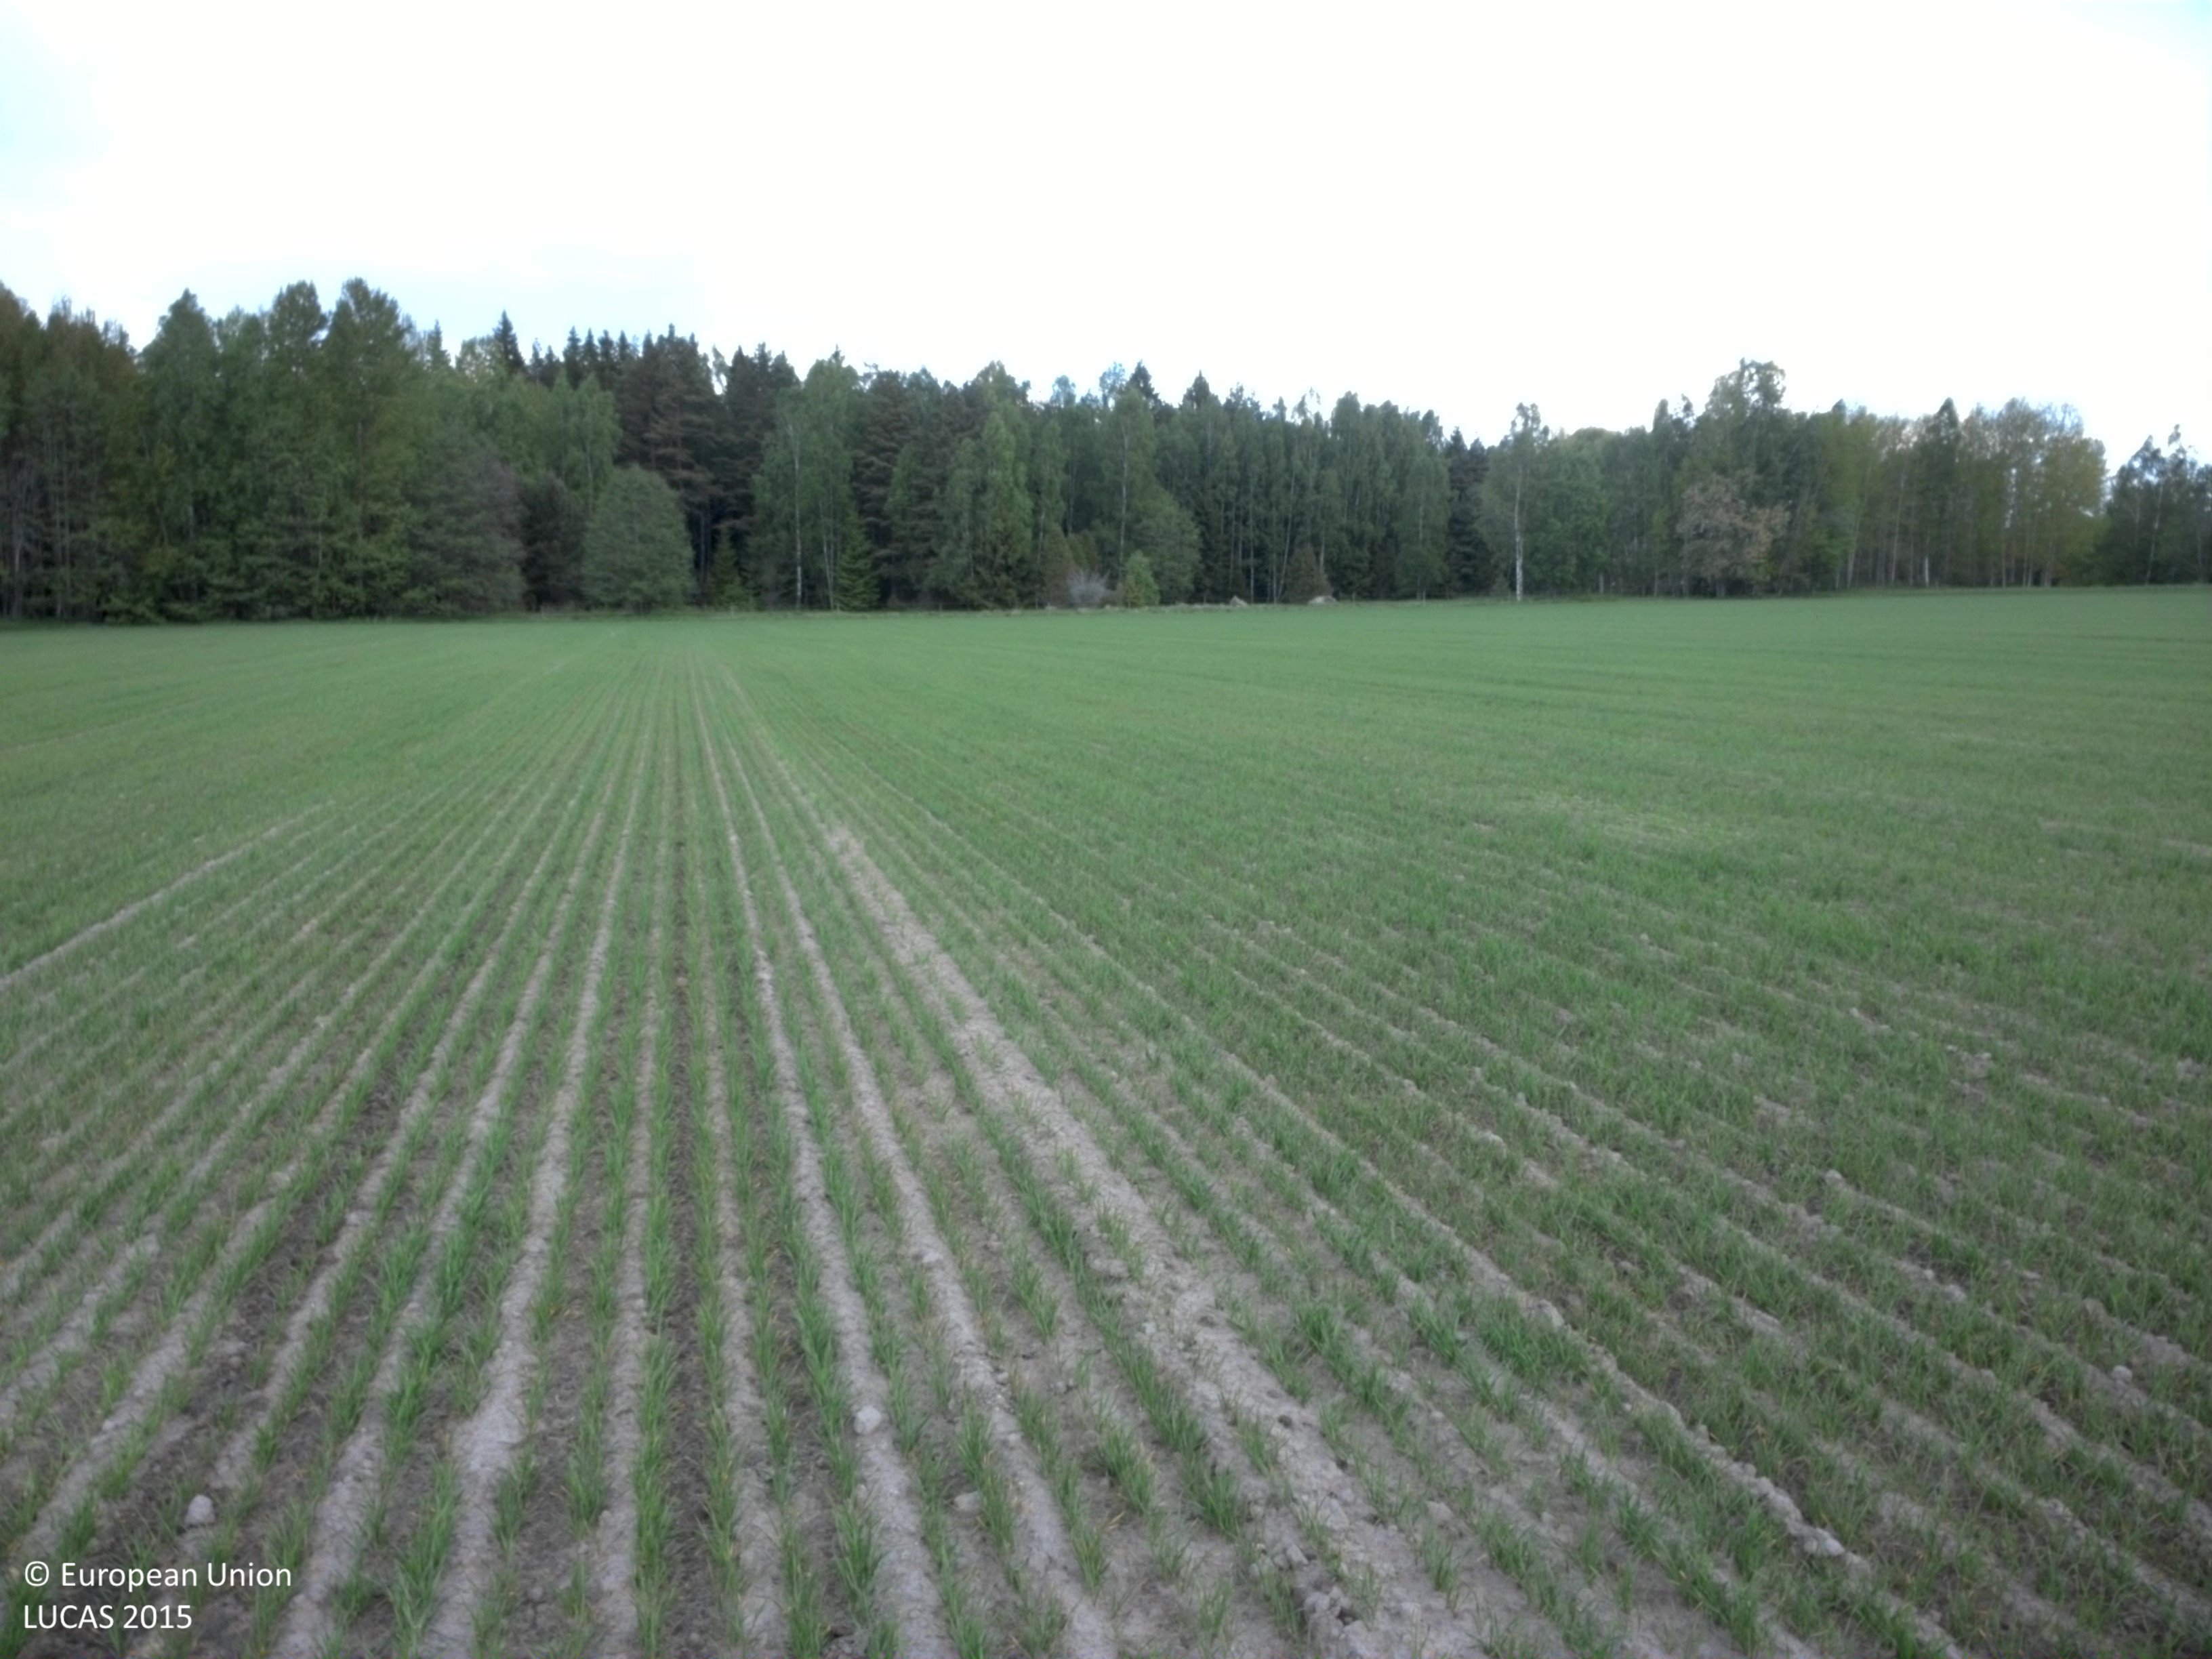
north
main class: Cropland
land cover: Common wheat
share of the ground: 50 - 75 %
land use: Agriculture (excluding fallow land and kitchen gardens)
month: May
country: SE
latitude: 57.3356
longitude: 15.8288
